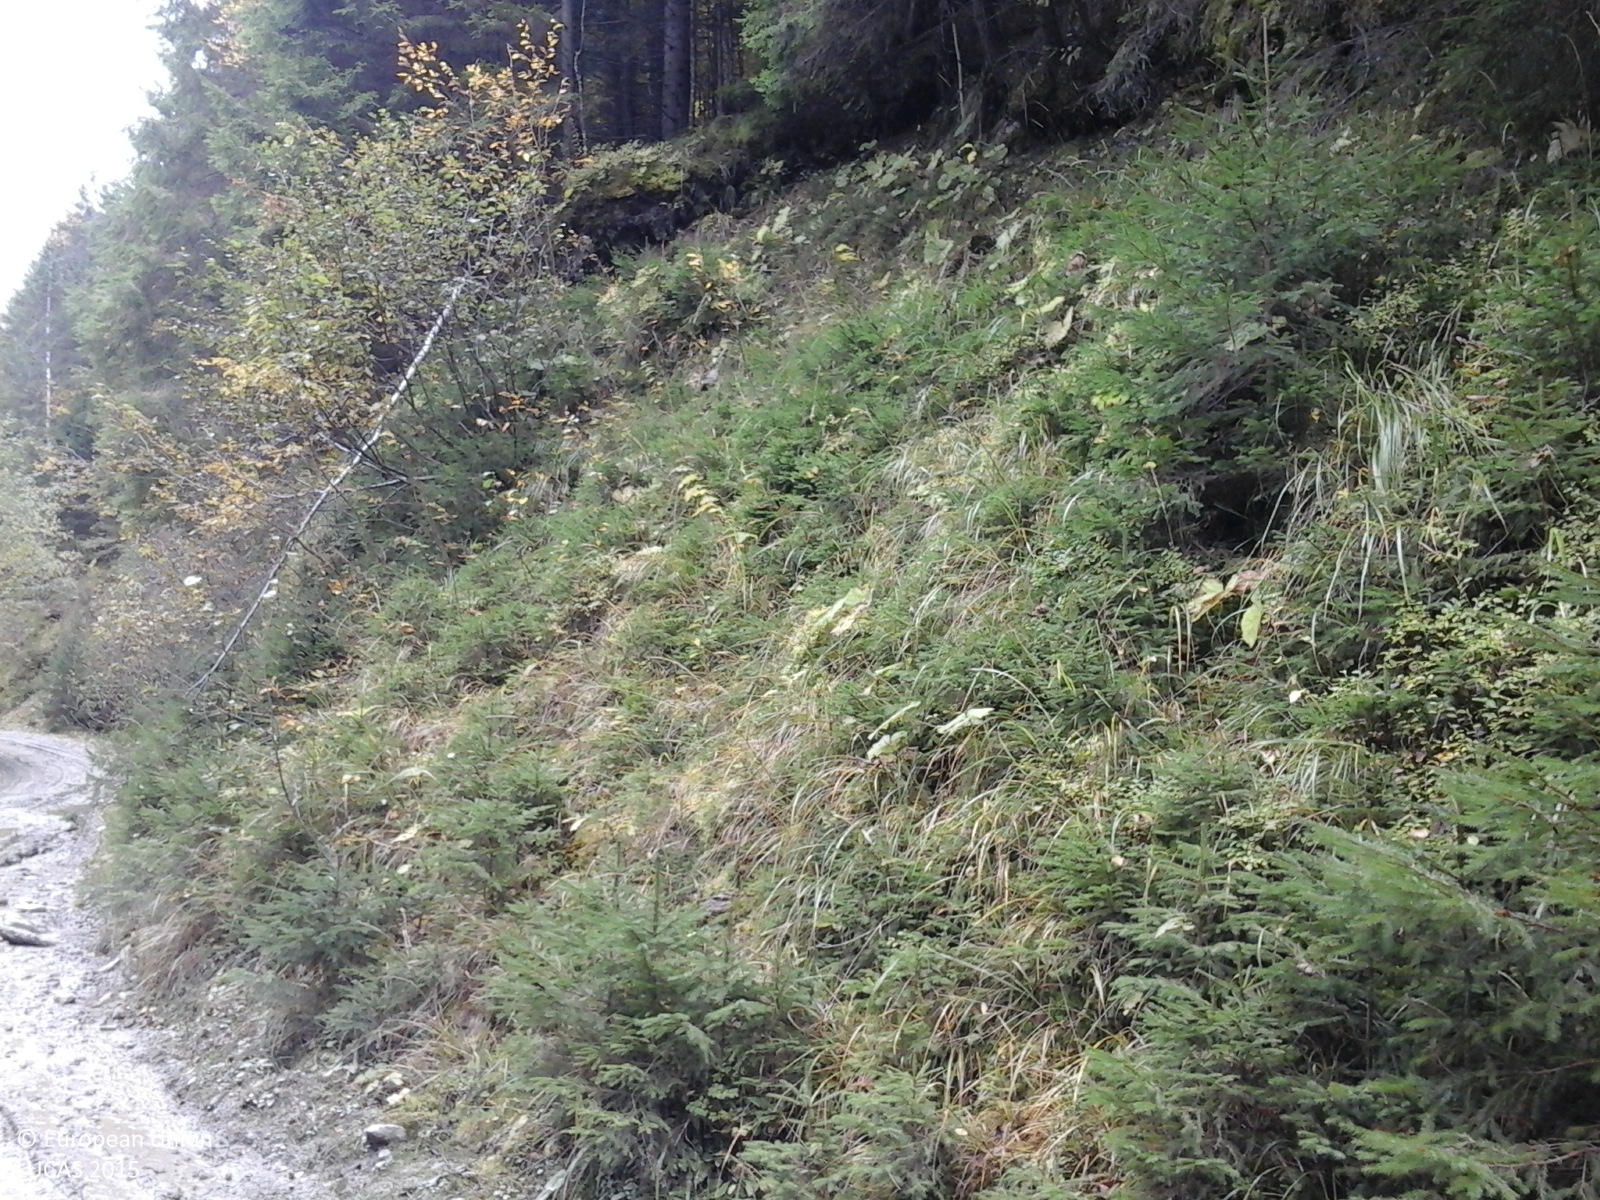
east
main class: Woodland
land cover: Spruce dominated mixed woodland
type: alpine coniferous forest
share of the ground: > 75 %
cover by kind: coniferous forest trees 75 %, broadleaved forest trees 25 %
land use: Forestry
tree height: > 5 m
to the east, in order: Spruce dominated mixed woodland; Tracks; Spruce dominated mixed woodland
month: October
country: RO
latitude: 45.5688
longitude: 25.0706
